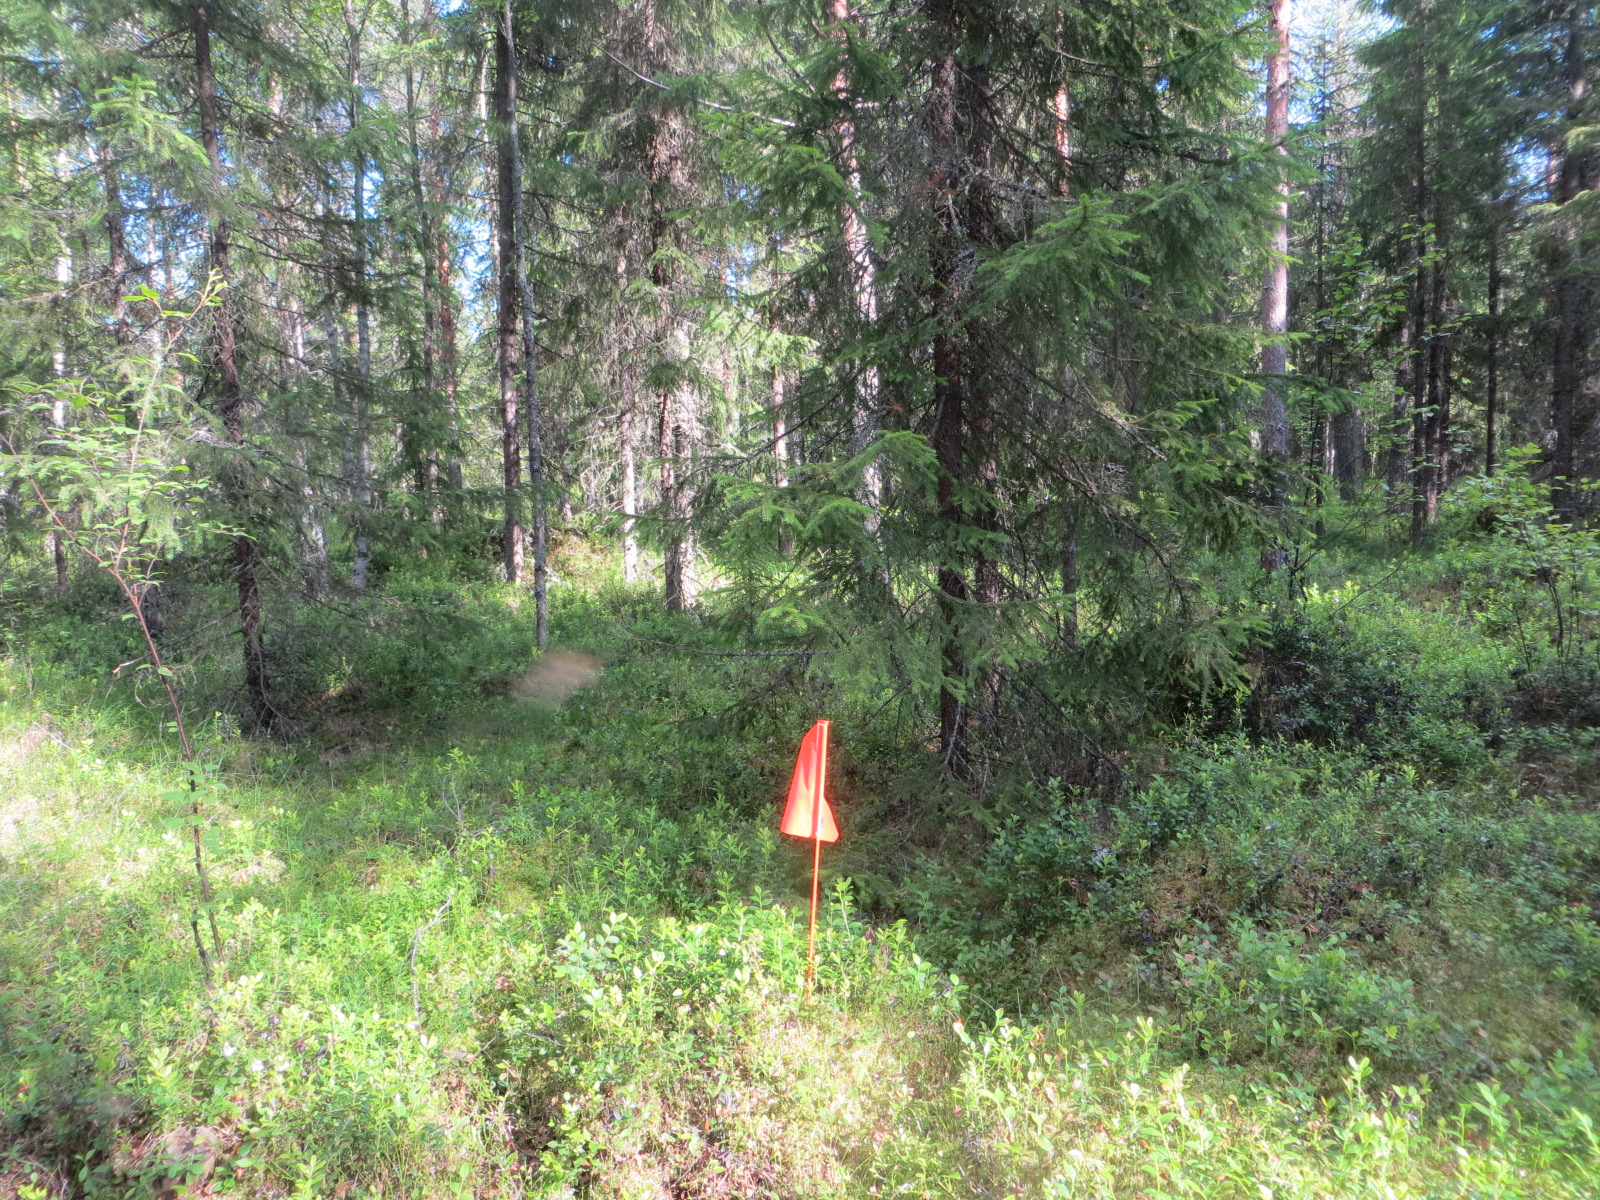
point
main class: Woodland
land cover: Other coniferous woodland
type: boreal forest
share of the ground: 50 - 75 %
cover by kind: coniferous forest trees 60 %, shrubs 40 %
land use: Forestry
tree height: > 5 m
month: July
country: FI
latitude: 65.4549
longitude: 25.3712
